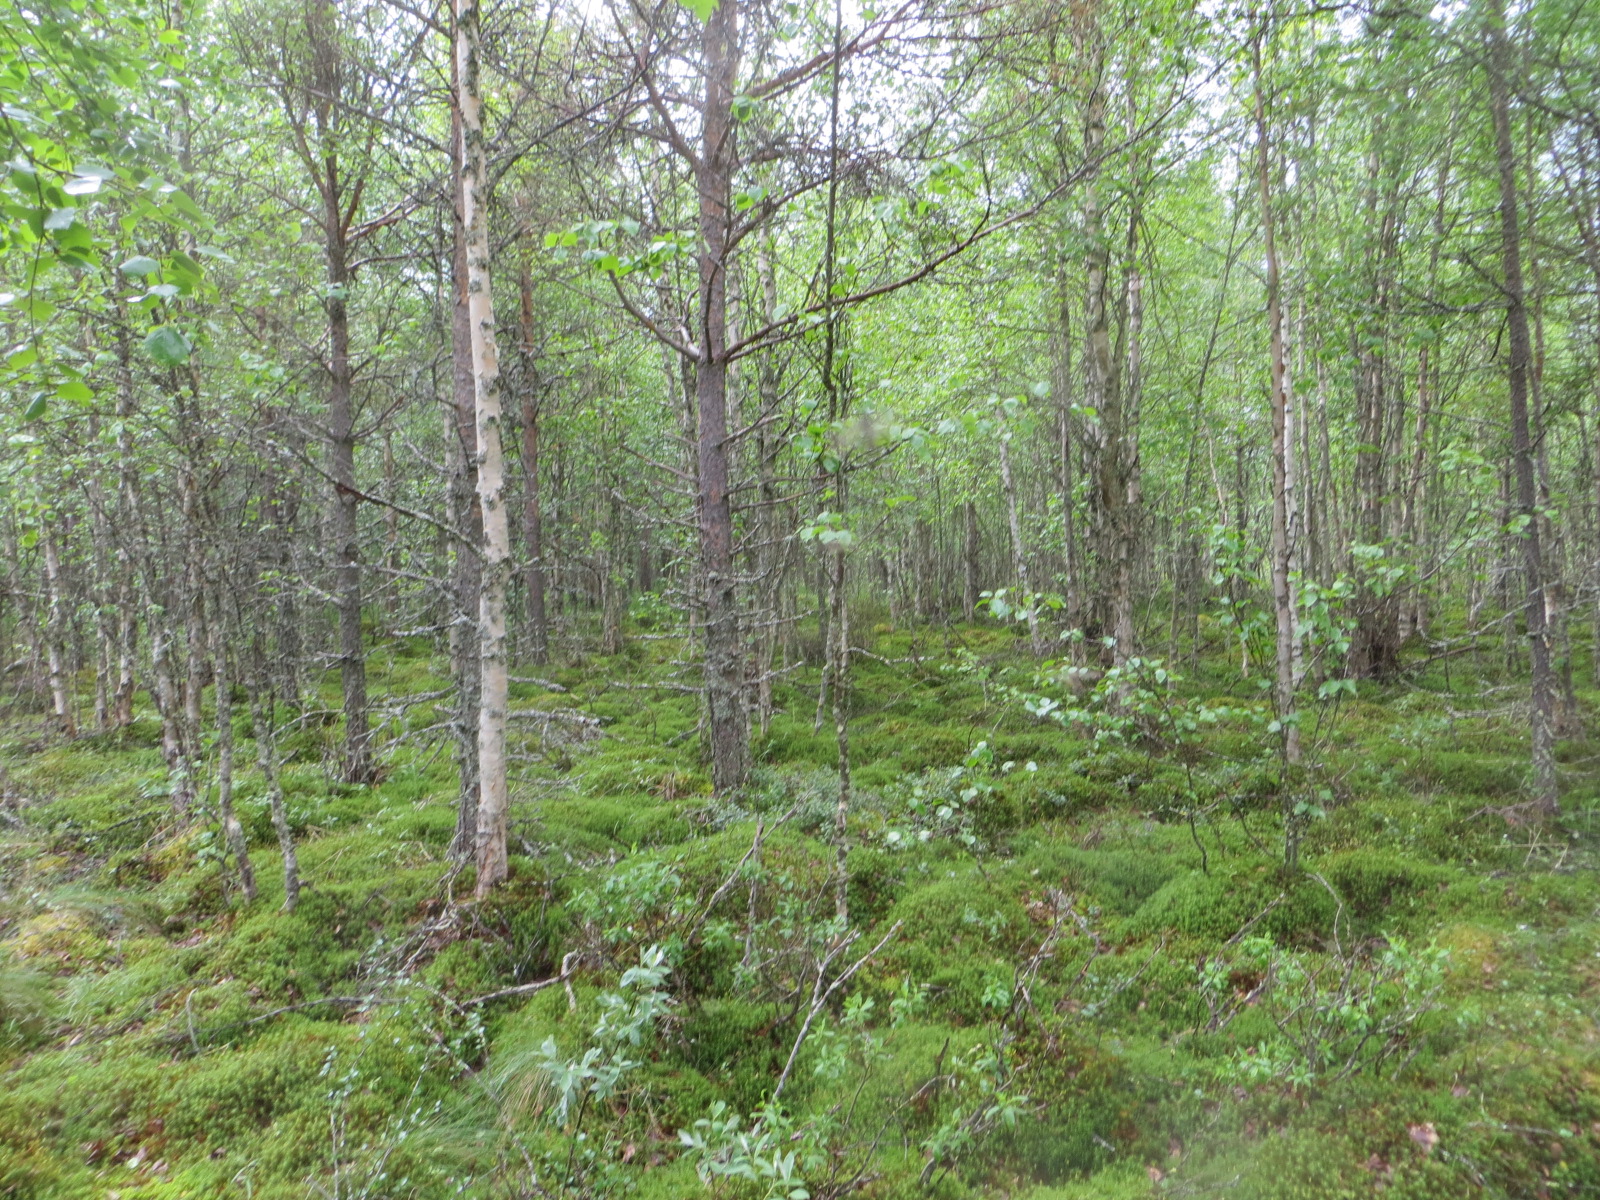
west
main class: Woodland
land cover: Broadleaved woodland
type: boreal forest
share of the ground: > 75 %
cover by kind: broadleaved forest trees 80 %, lichens and mosses 10 %, shrubs 5 %, herbaceous plants 5 %
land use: Forestry
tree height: > 5 m
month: June
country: FI
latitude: 66.0990
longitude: 26.9370
